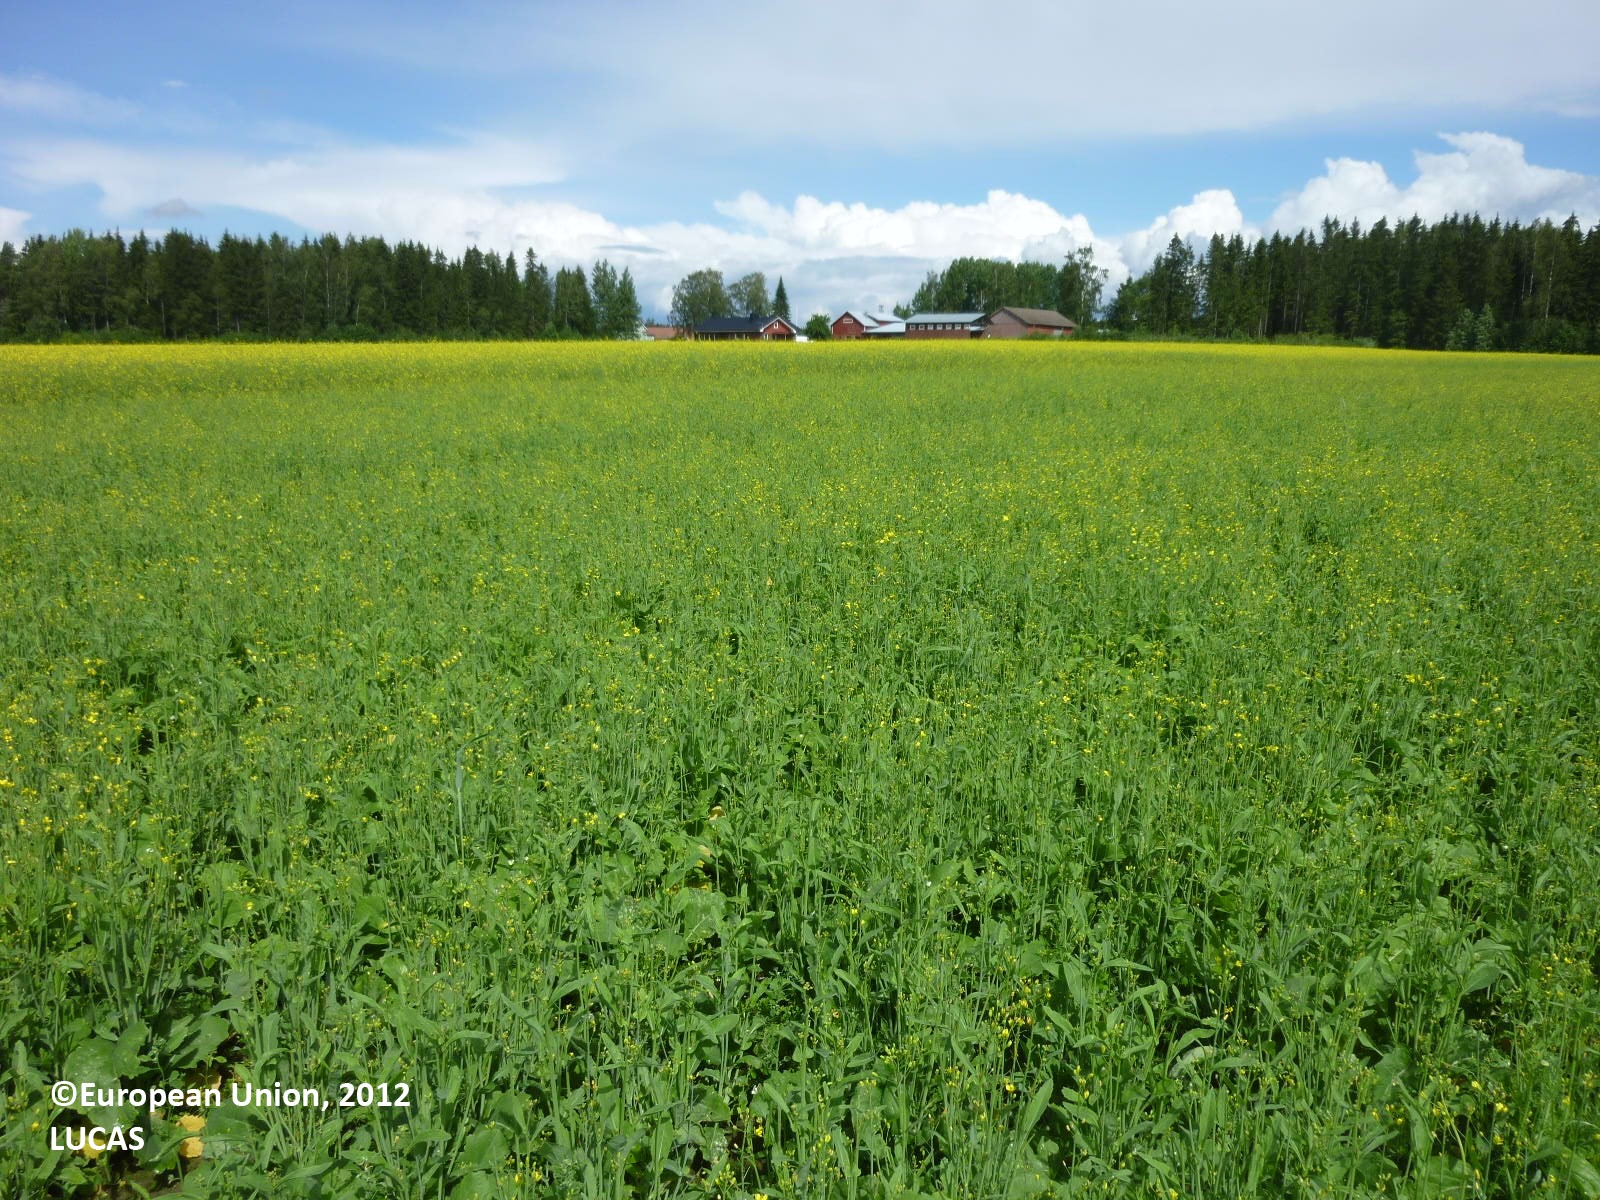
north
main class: Cropland
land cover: Common wheat
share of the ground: > 75 %
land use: Agriculture (excluding fallow land and kitchen gardens)
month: July
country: FI
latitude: 61.2471
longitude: 22.0794
